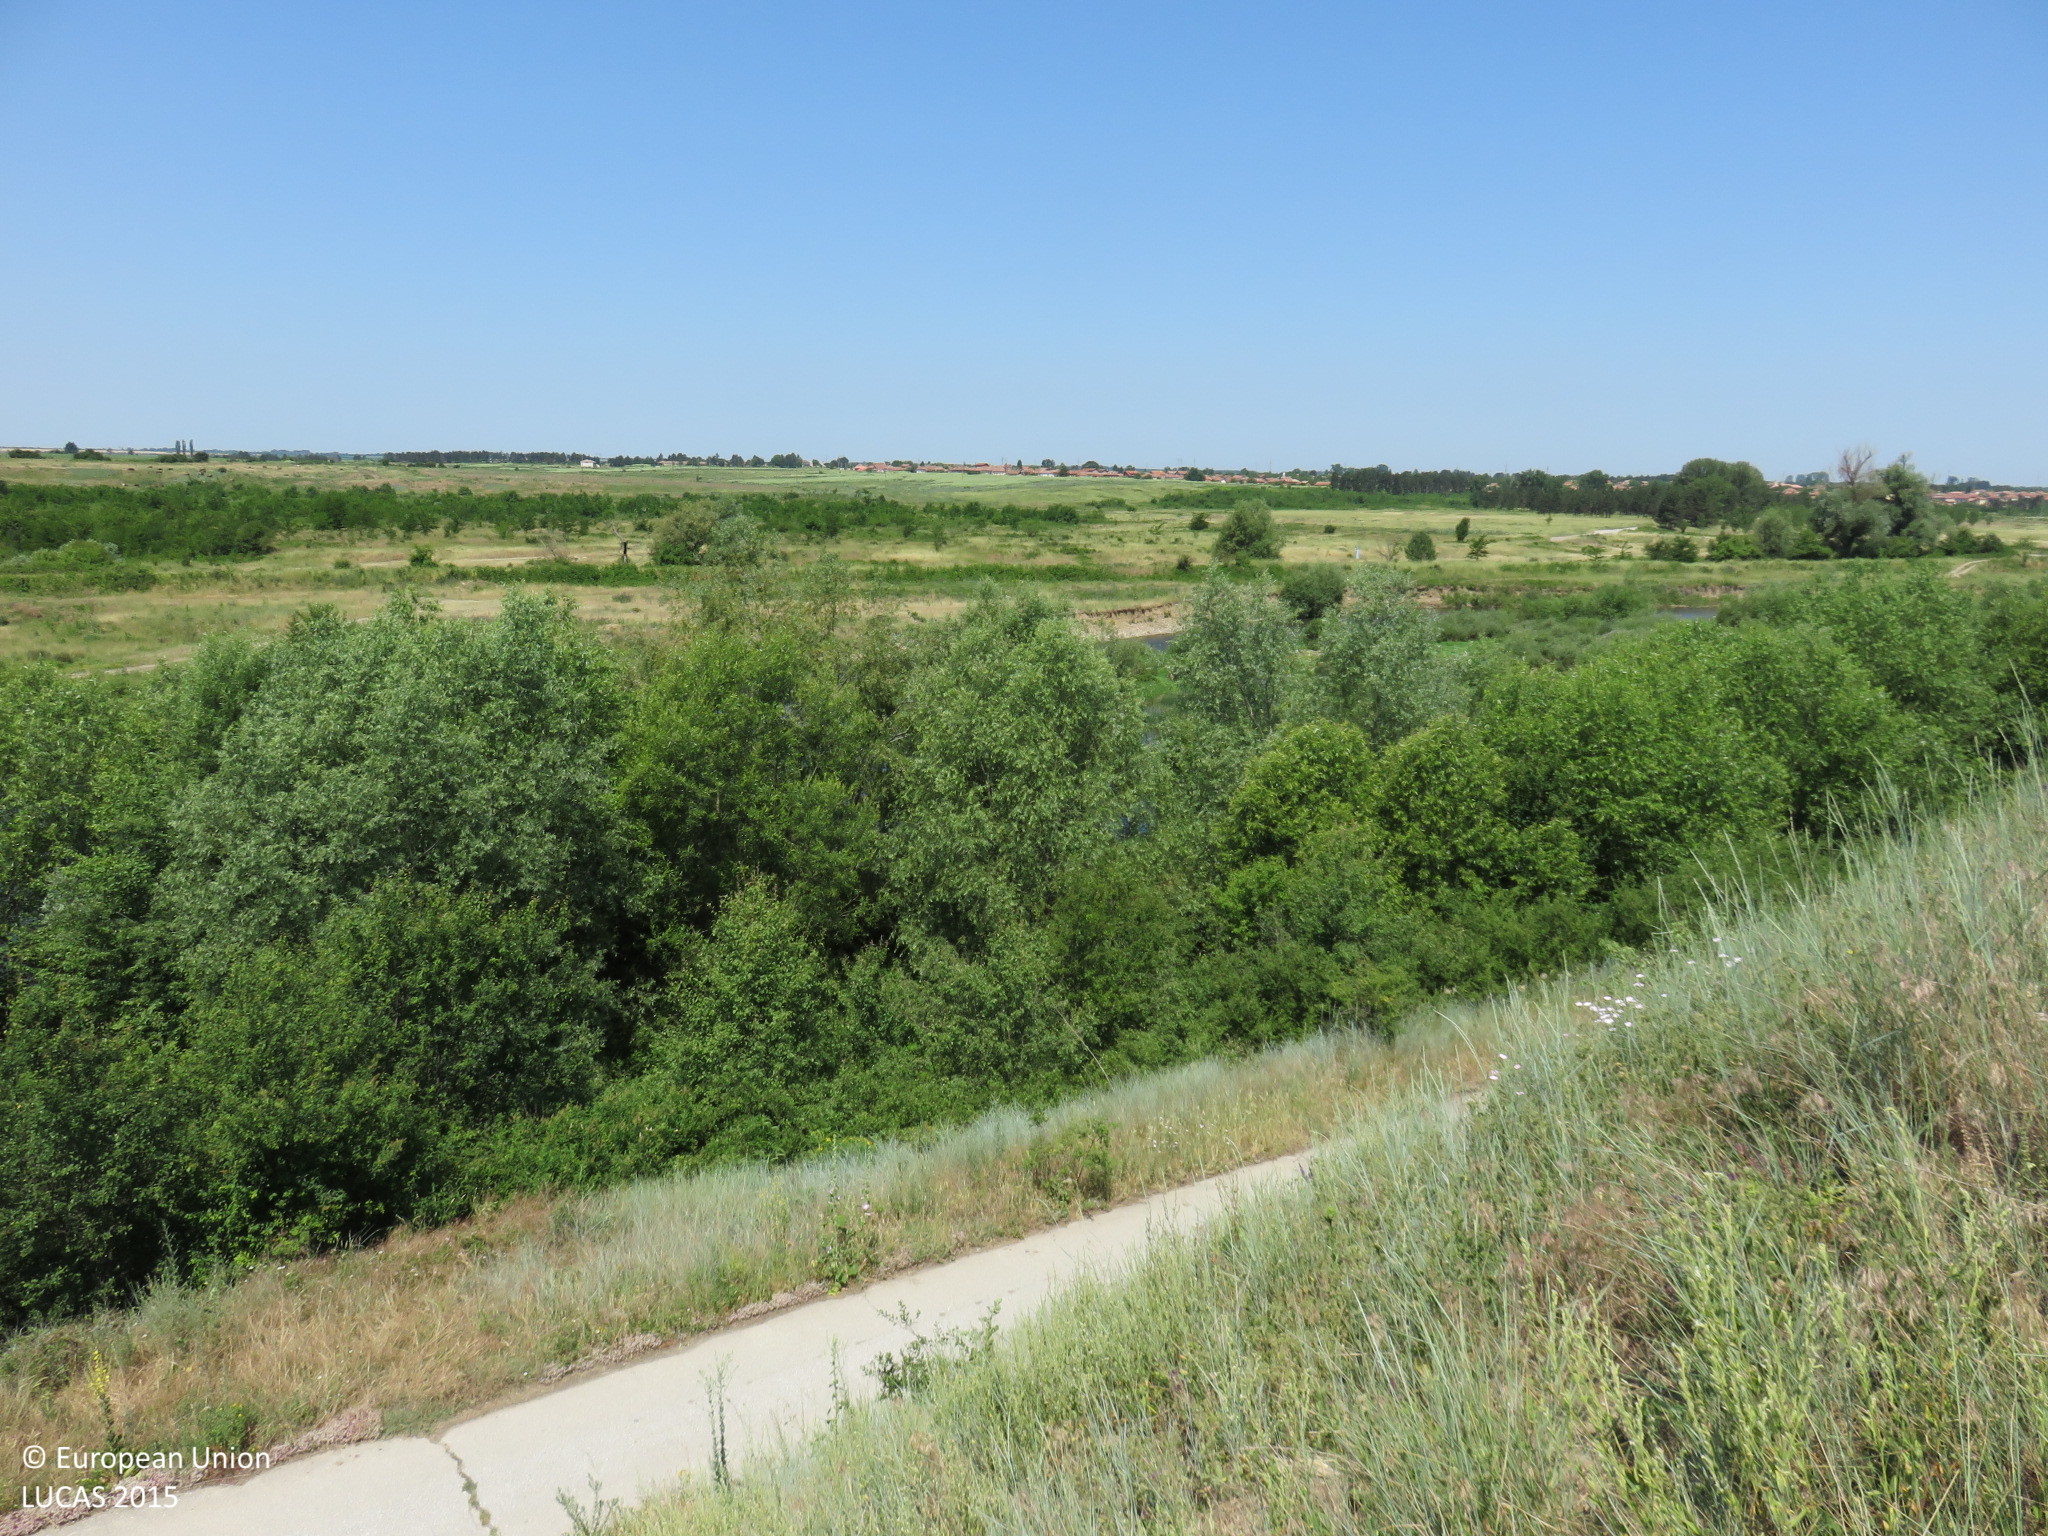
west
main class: Grassland
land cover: Grassland without tree/shrub cover
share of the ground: > 75 %
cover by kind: herbaceous plants 100 %
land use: Agriculture (excluding fallow land and kitchen gardens)
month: June
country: BG
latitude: 43.3360
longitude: 24.4279
